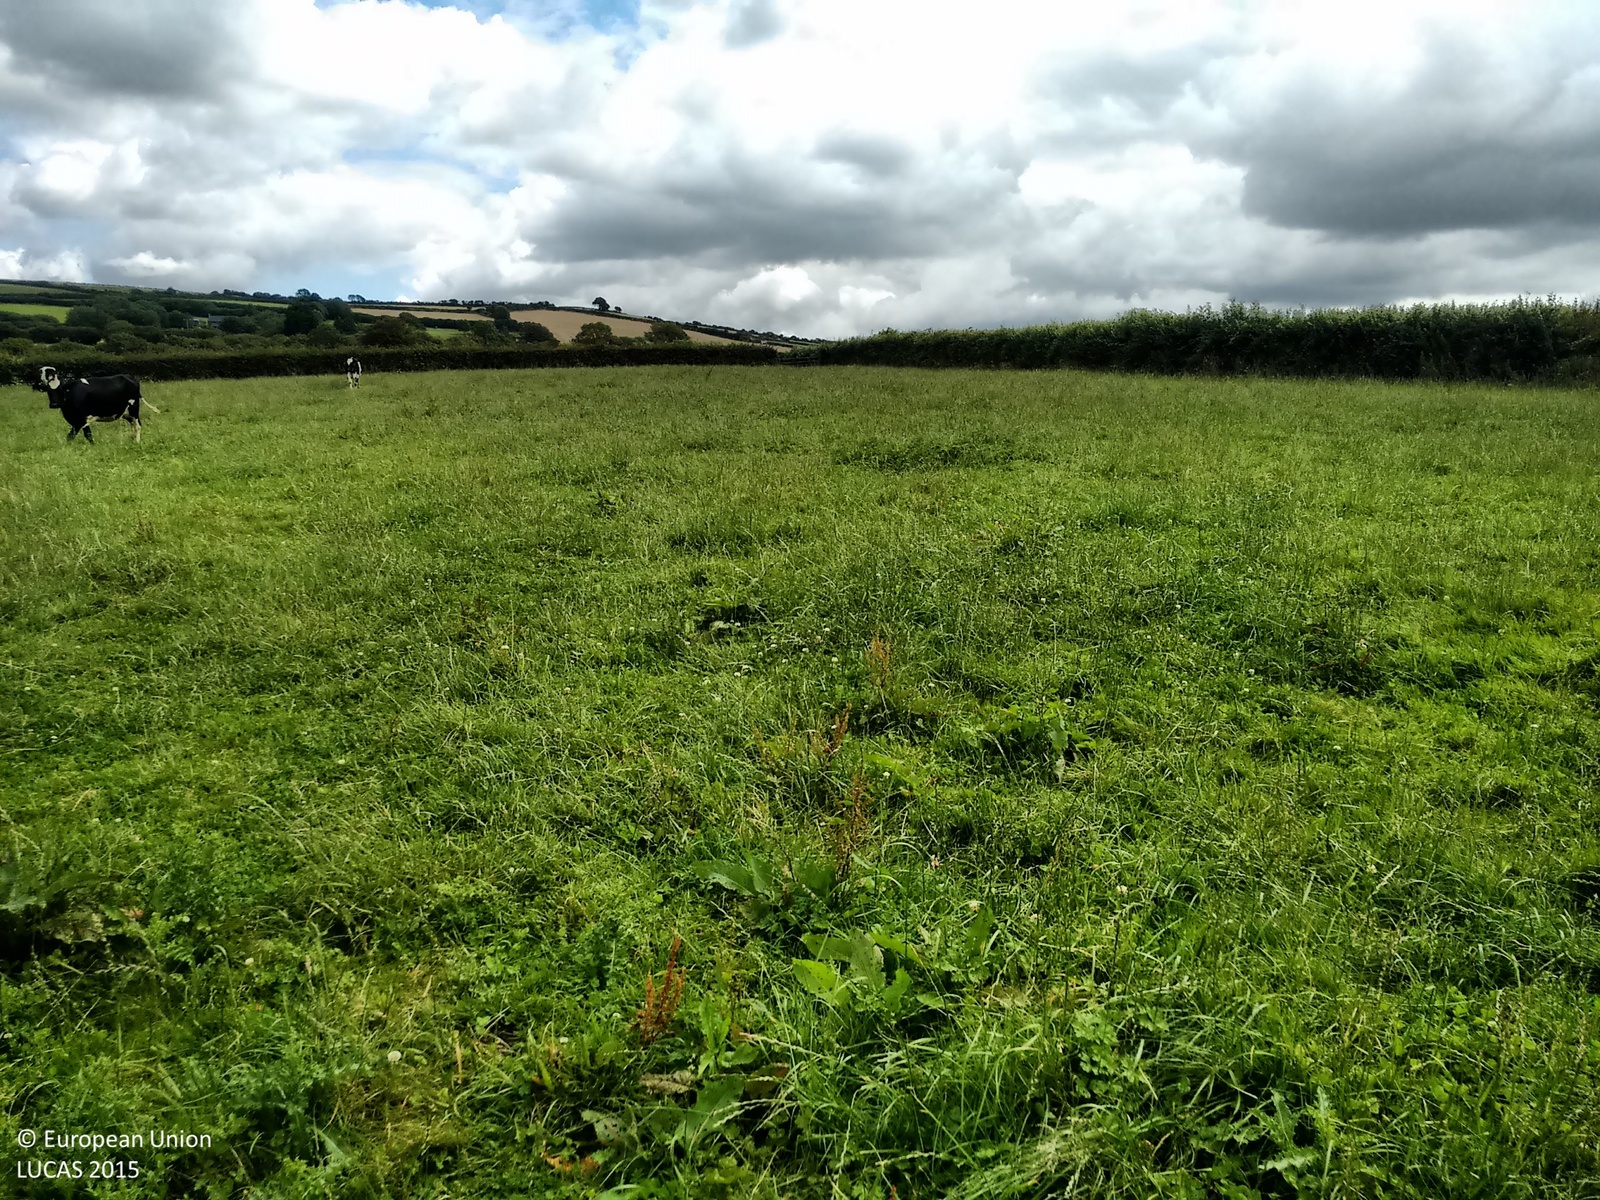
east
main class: Grassland
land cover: Grassland without tree/shrub cover
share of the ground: > 75 %
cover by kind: herbaceous plants 100 %
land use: Agriculture (excluding fallow land and kitchen gardens)
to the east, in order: Grassland without tree/shrub cover; Managed hedges; Shruby margins; Paved roads, cycling and walking lanes; Spontaneously vegetated surfaces; Managed hedges; Fences; Grassland without tree/shrub cover; Fences; Managed hedges; Paved roads, cycling and walking lanes; Managed hedges; Fences; Other leguminous and mixtures for fodder
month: August
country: GB
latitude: 50.3983
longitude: -3.9495
